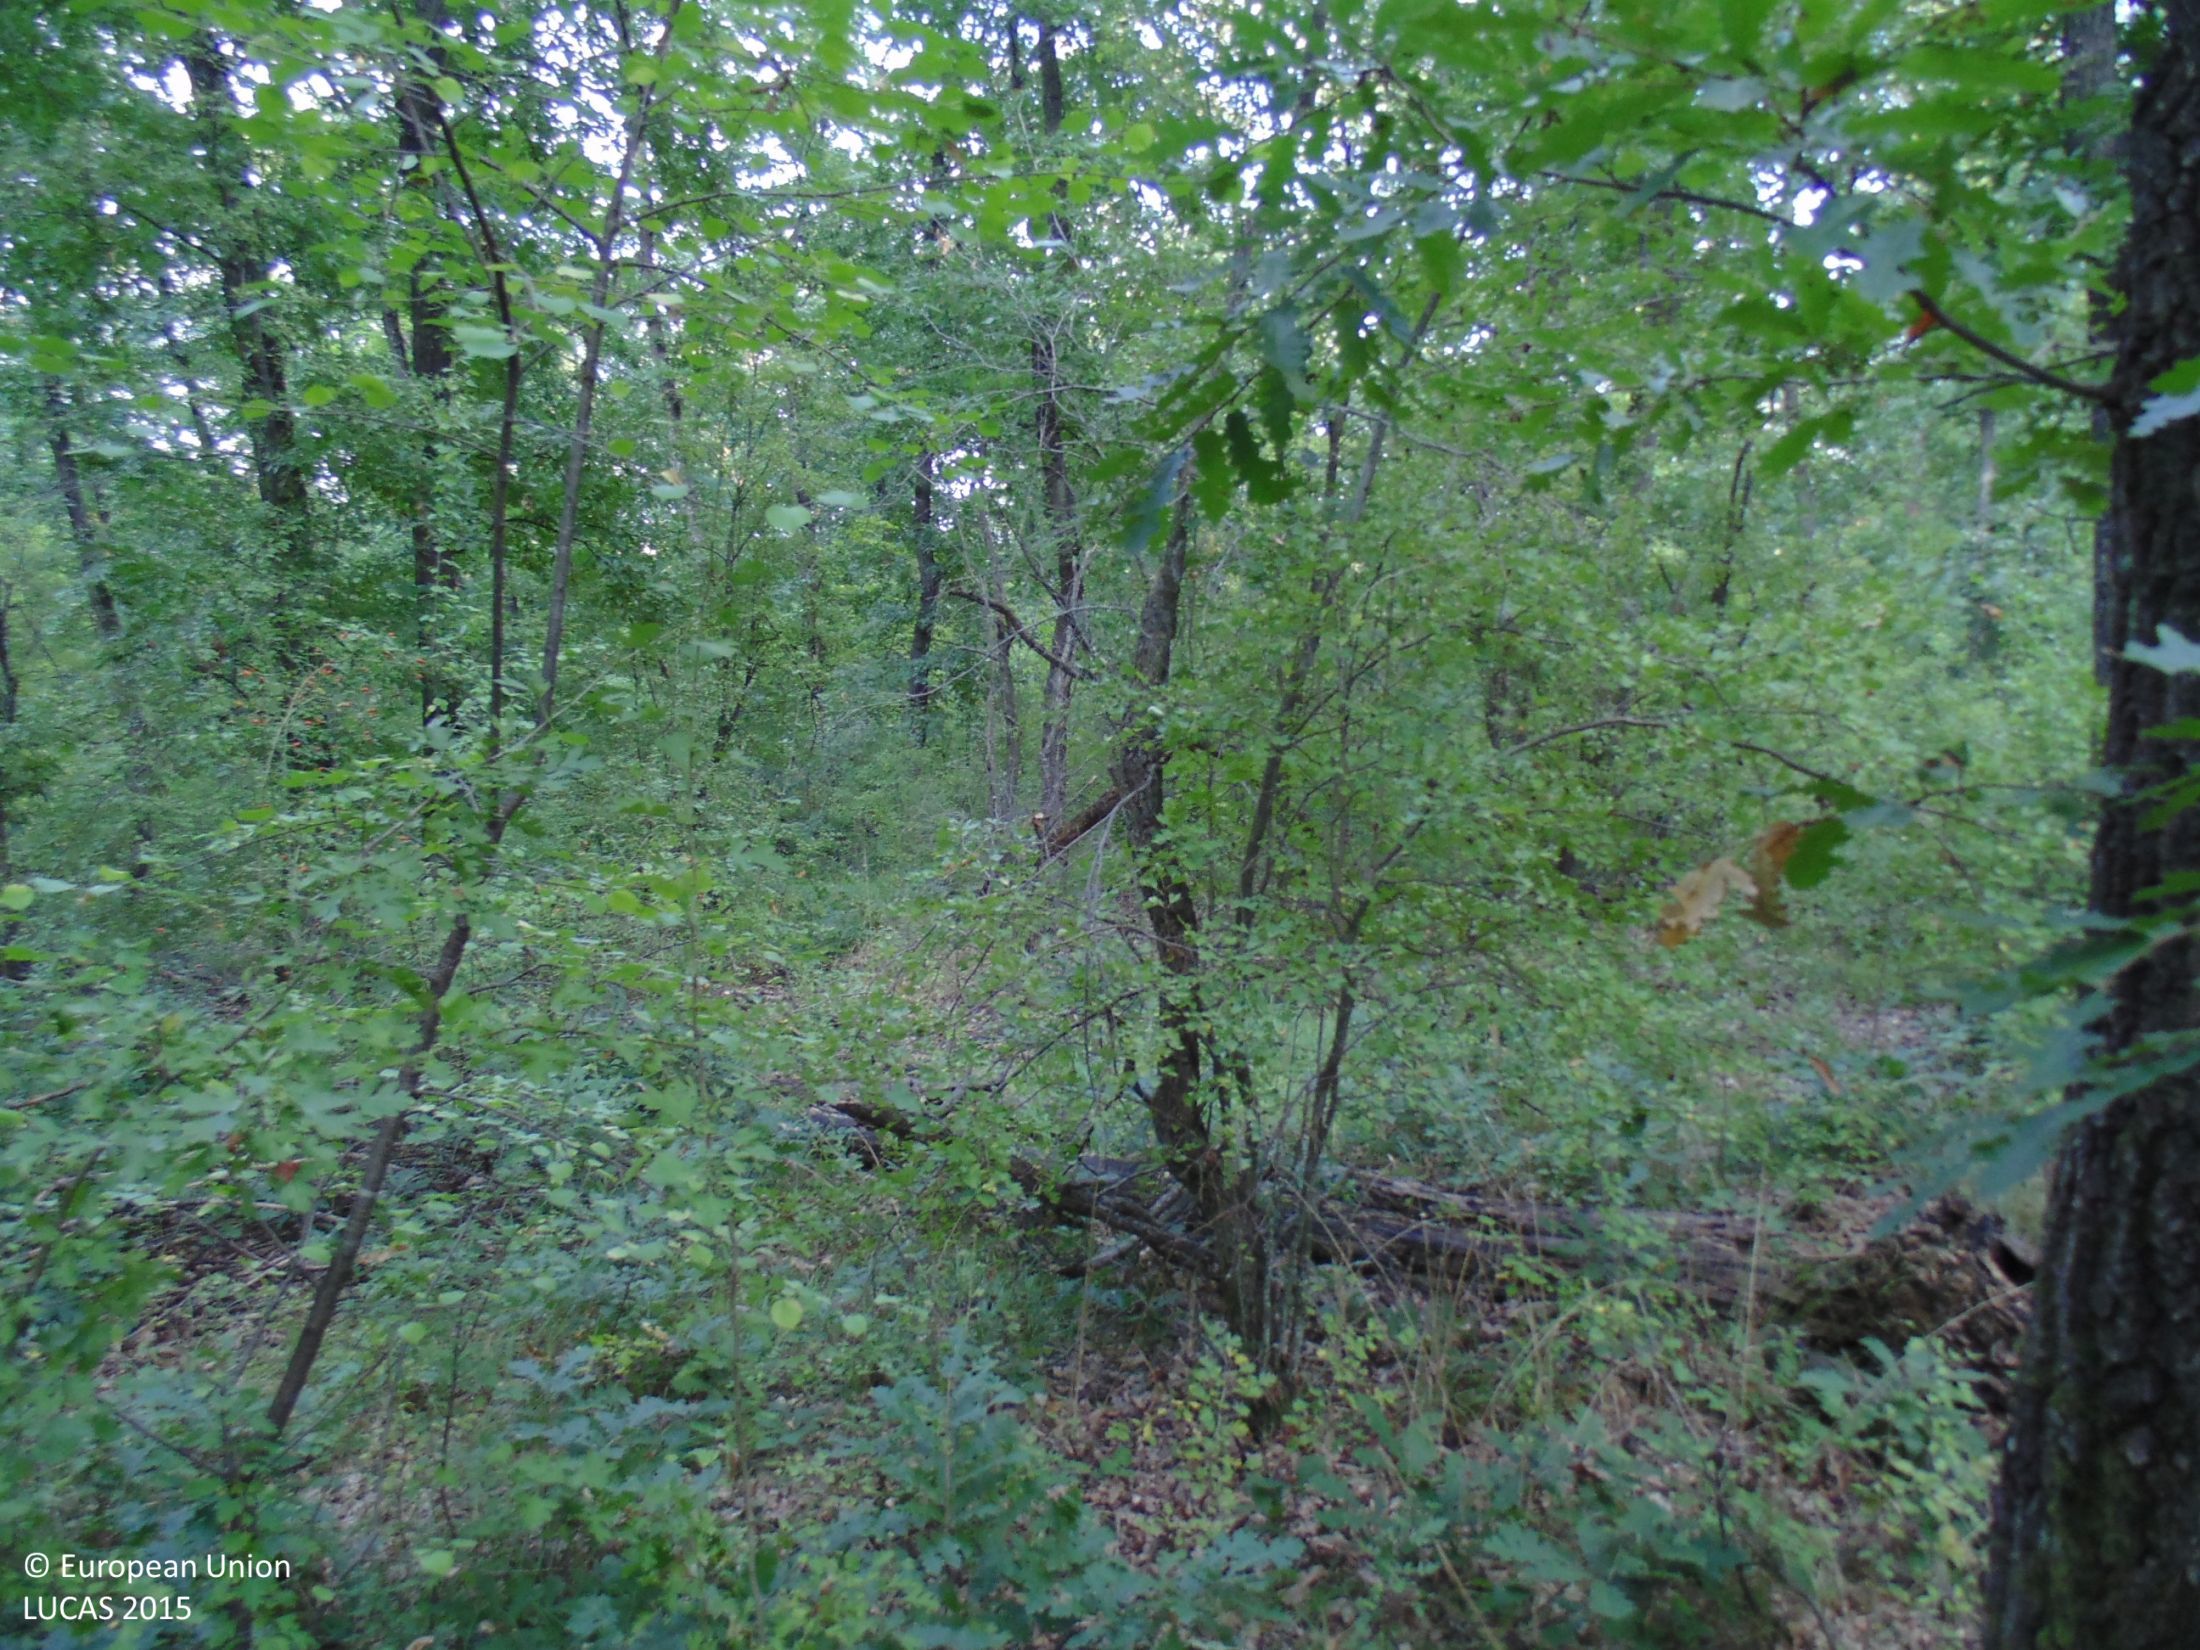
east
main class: Woodland
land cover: Broadleaved woodland
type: mesophytic deciduous forest
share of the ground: > 75 %
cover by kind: broadleaved forest trees 90 %, shrubs 5 %, unconsolidated bare surface 5 %
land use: Forestry
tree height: > 5 m
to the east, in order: Broadleaved woodland
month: August
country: BG
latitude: 43.8029
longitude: 27.5248
